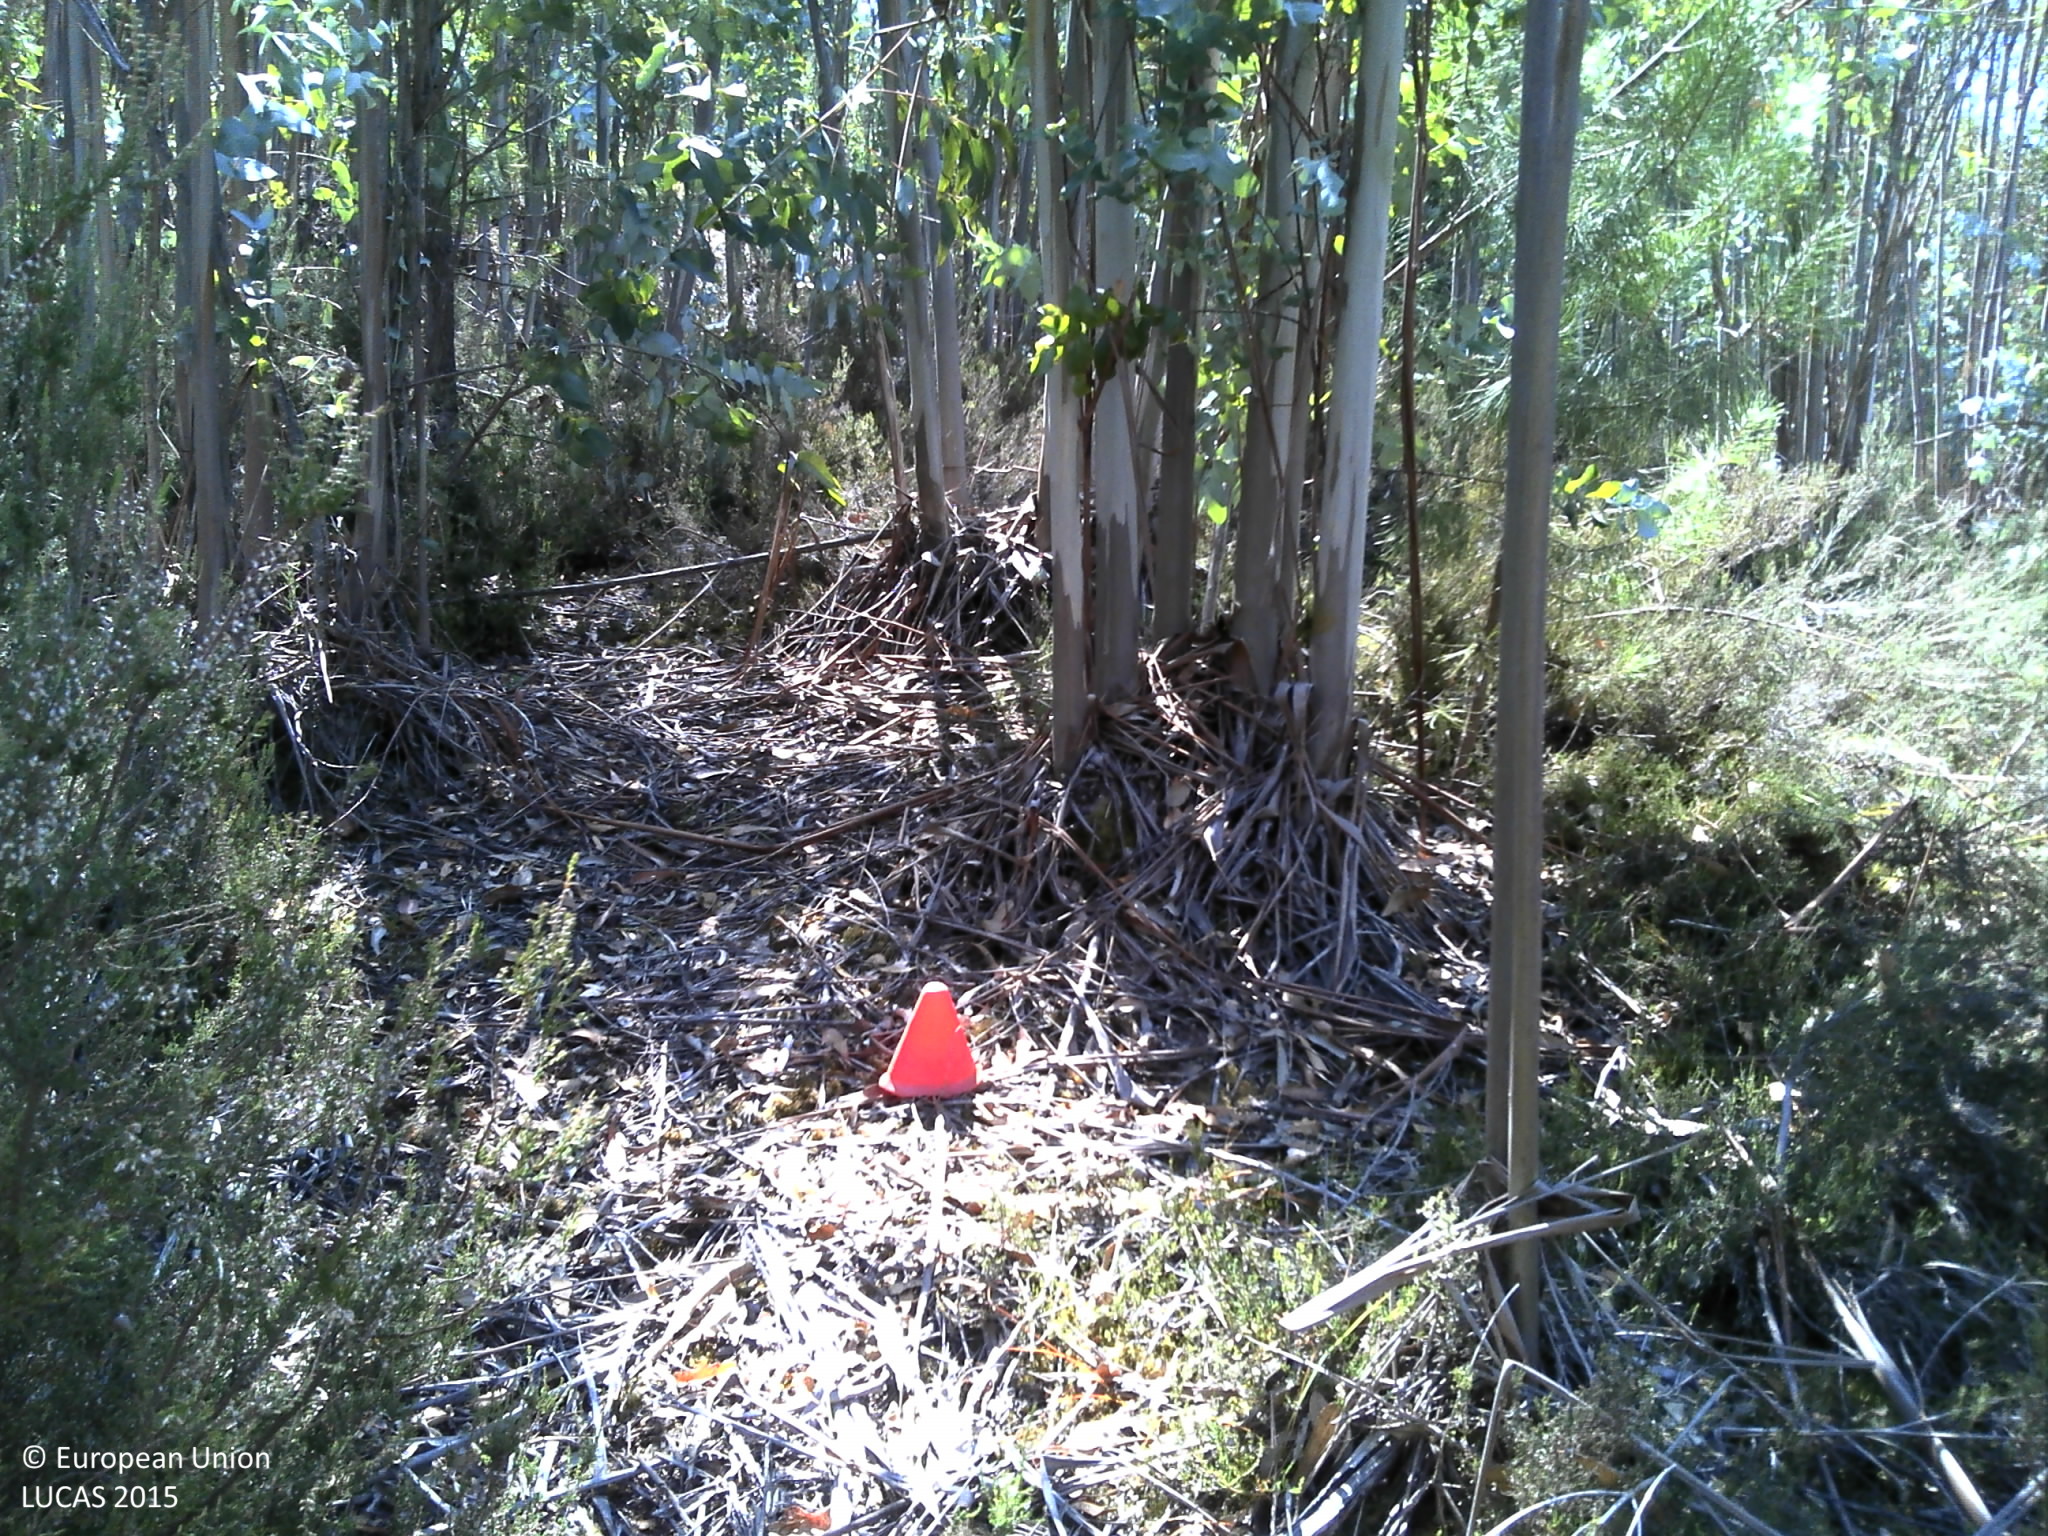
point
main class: Woodland
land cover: Broadleaved woodland
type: exotic forest
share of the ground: 10 - 25 %
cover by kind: shrubs 80 %, broadleaved forest trees 15 %, unconsolidated bare surface 5 %
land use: Forestry
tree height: > 5 m
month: July
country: PT
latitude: 40.0099
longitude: -8.1967
